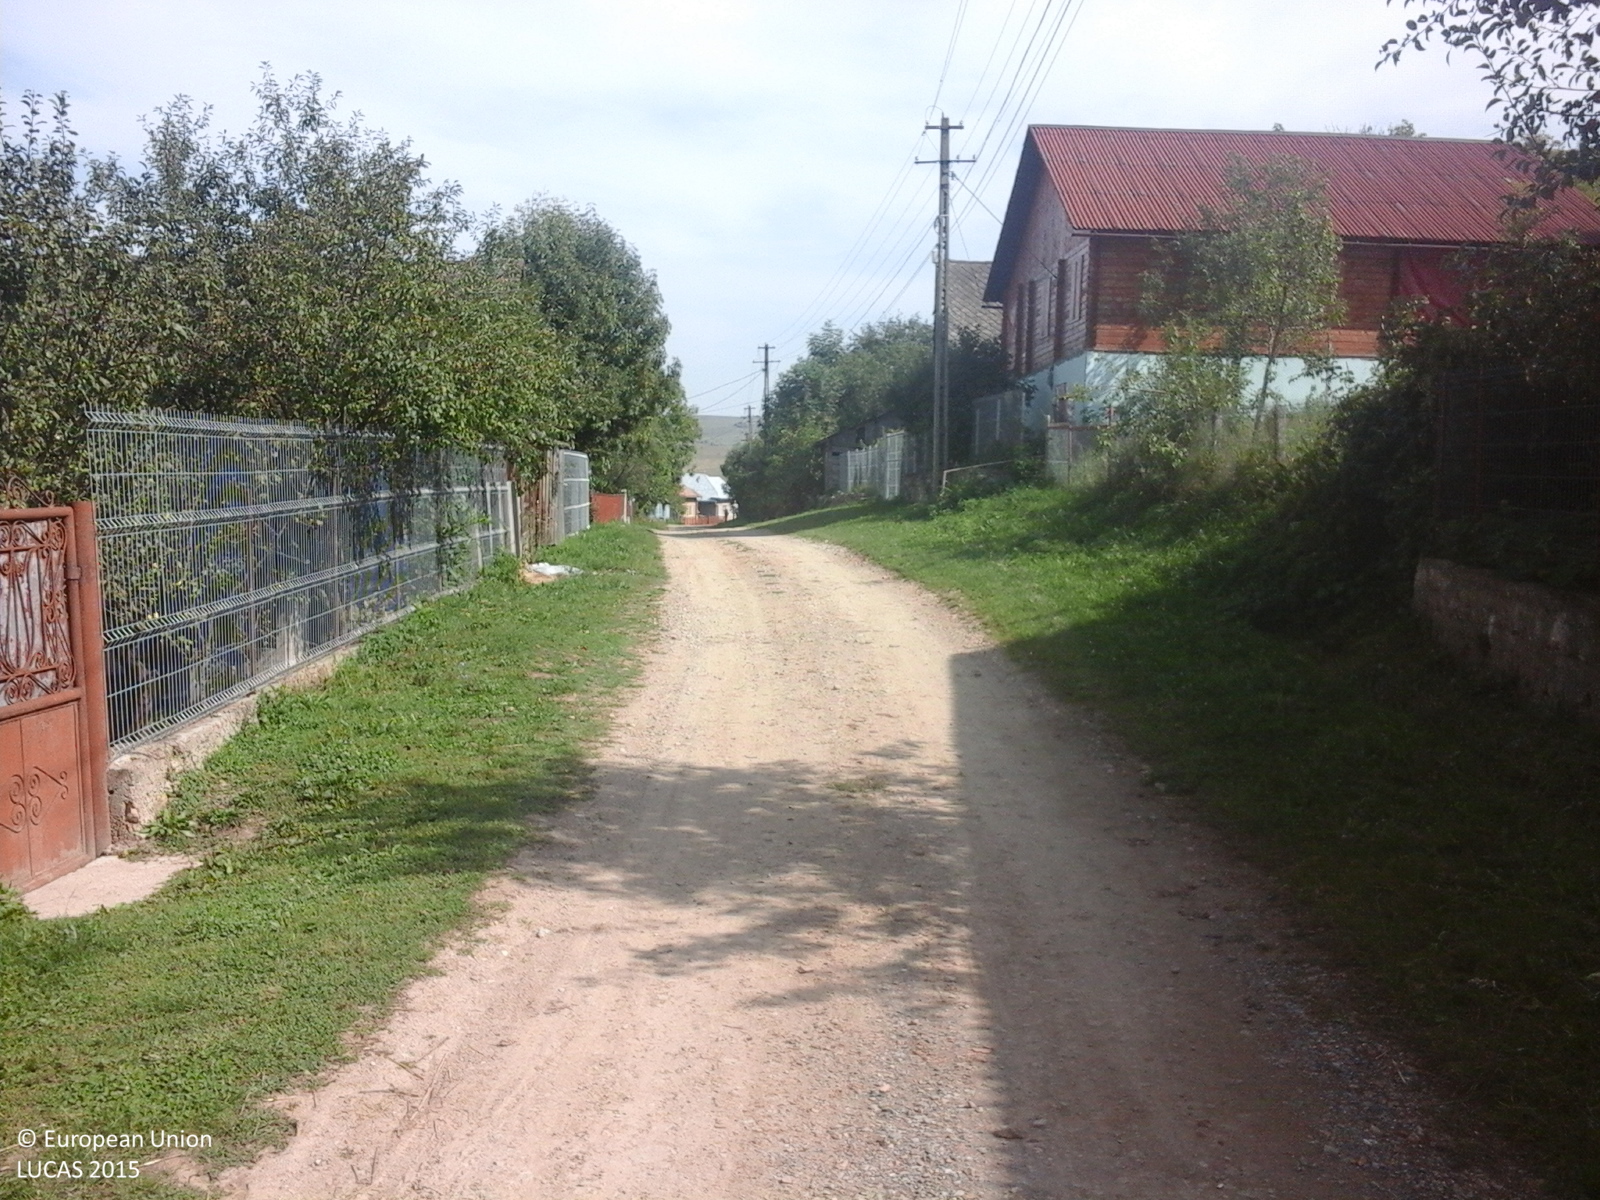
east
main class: Cropland
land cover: Apple fruit
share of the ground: > 75 %
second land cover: Grassland without tree/shrub cover
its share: > 75 %
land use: Agriculture (excluding fallow land and kitchen gardens)
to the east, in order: Apple fruit; Grassland without tree/shrub cover; Fences; Other leguminous and mixtures for fodder; Fences; Lines of trees; Broadleaved woodland; Artificial constructions in urban areas
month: September
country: RO
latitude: 46.8079
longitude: 23.1815
